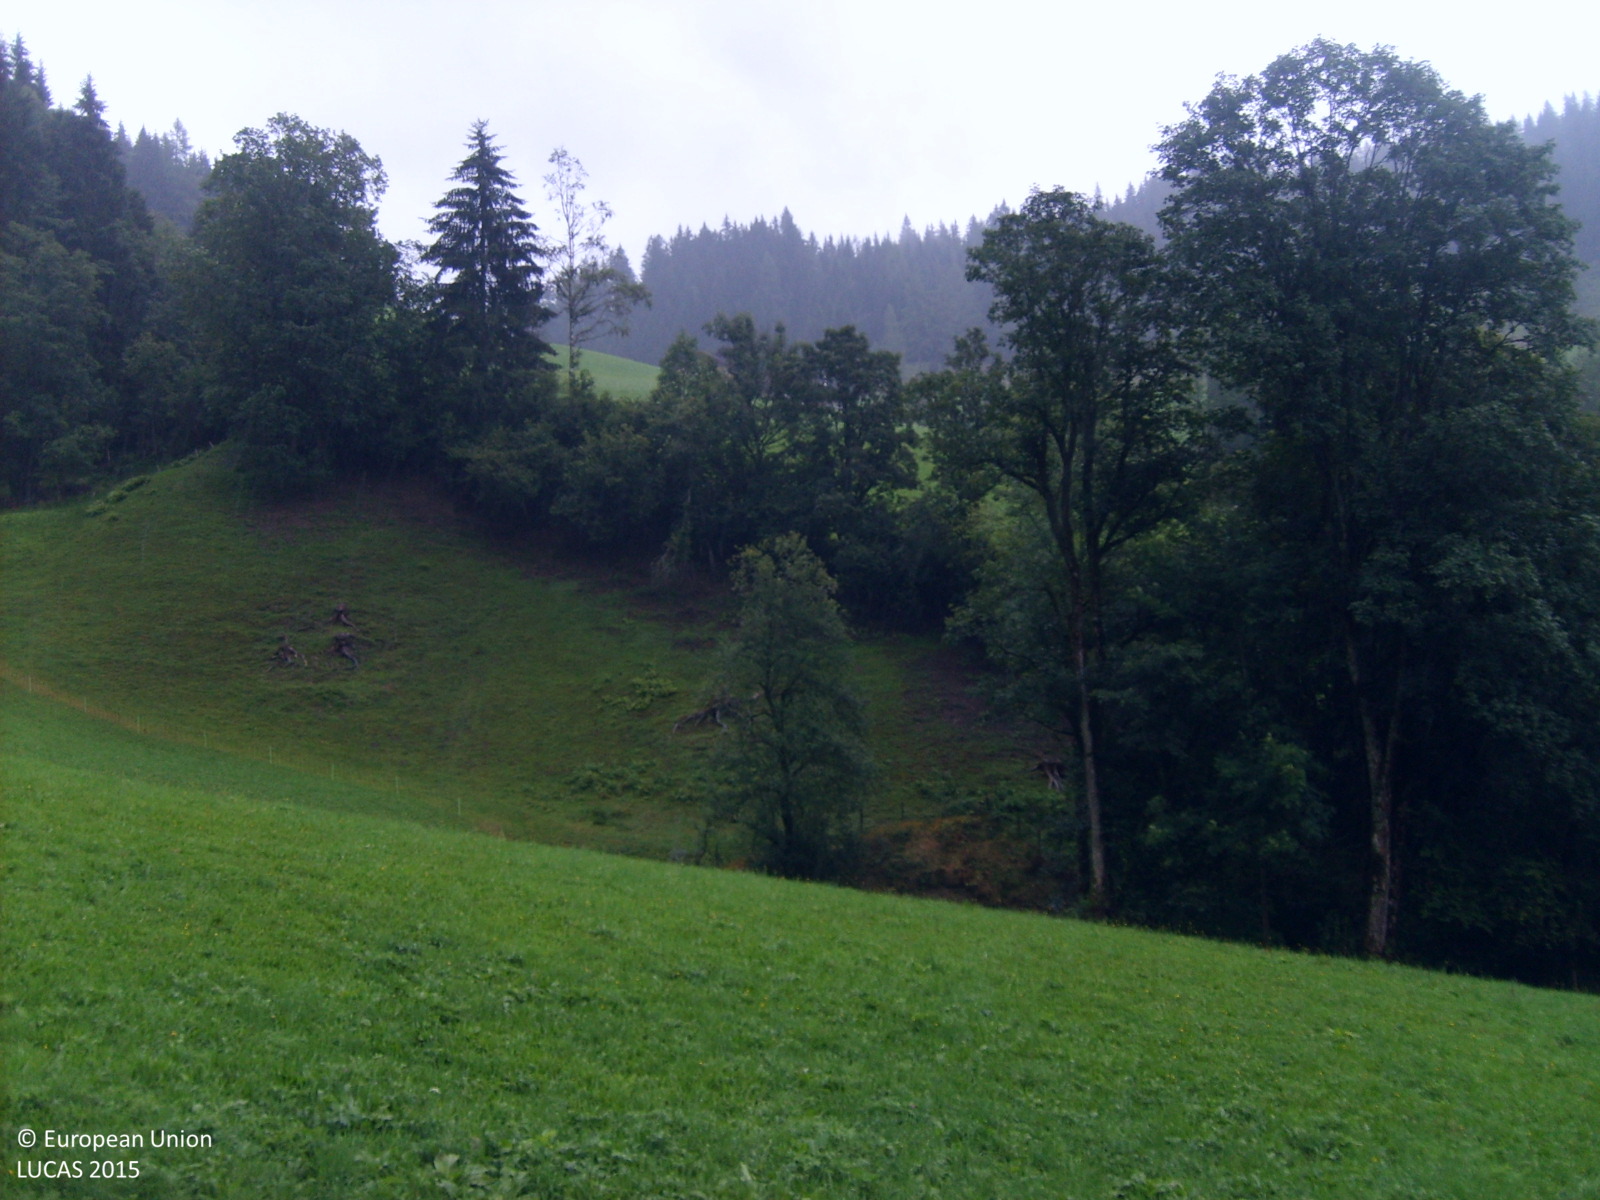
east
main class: Grassland
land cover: Grassland without tree/shrub cover
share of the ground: > 75 %
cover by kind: herbaceous plants 100 %
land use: Agriculture (excluding fallow land and kitchen gardens)
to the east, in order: Grassland without tree/shrub cover; Fences; Grassland without tree/shrub cover; Fences; Rivers and streams; Broadleaved woodland; Fences; Grass margins; Tracks; Fences; Grassland with sparse tree/shrub cover; Fences; Broadleaved woodland; Fences; Grassland without tree/shrub cover
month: September
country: AT
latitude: 47.4357
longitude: 13.2997
